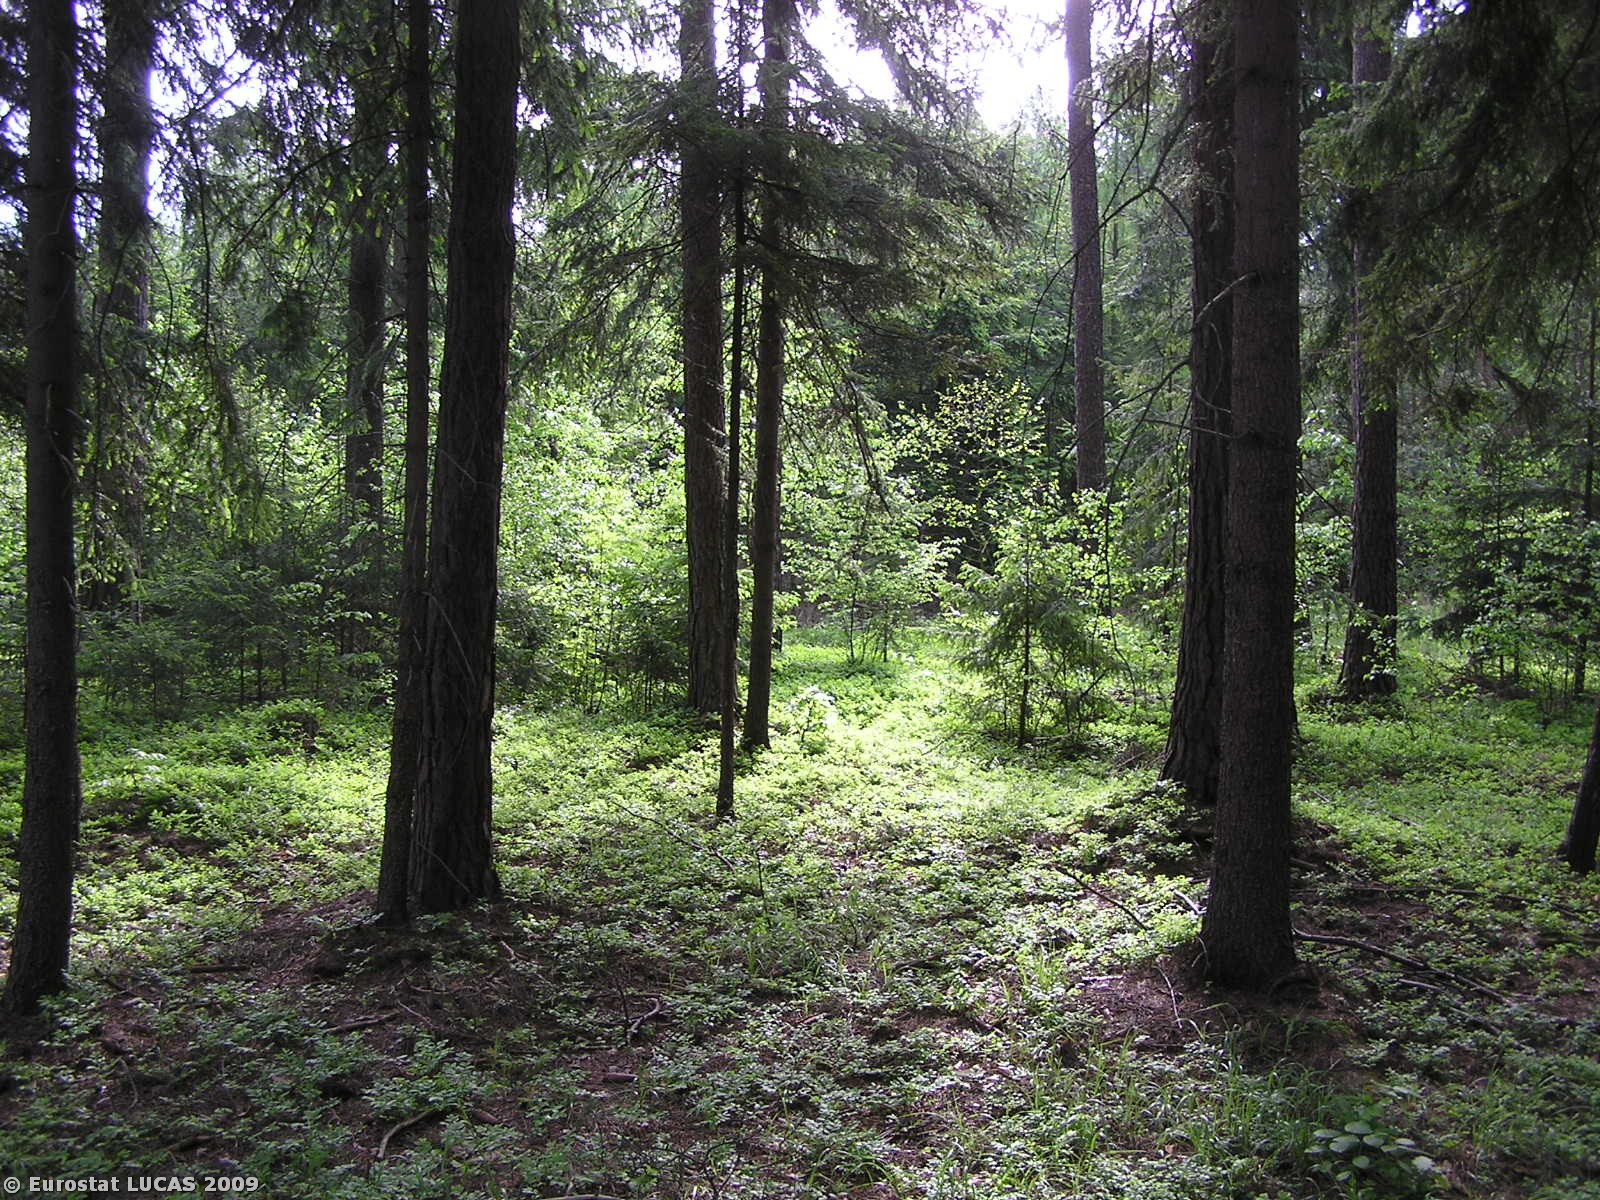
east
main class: Woodland
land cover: Coniferous woodland
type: hemiboreal forest and nemoral coniferous forest and mixed broadleaved-coniferous forest
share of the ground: > 75 %
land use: Forestry
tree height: > 5 m
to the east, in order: Coniferous woodland; Tracks; Coniferous woodland; Paved roads, cycling and walking lanes; Mixed woodland
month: May
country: CZ
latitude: 49.8943
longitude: 17.5996
